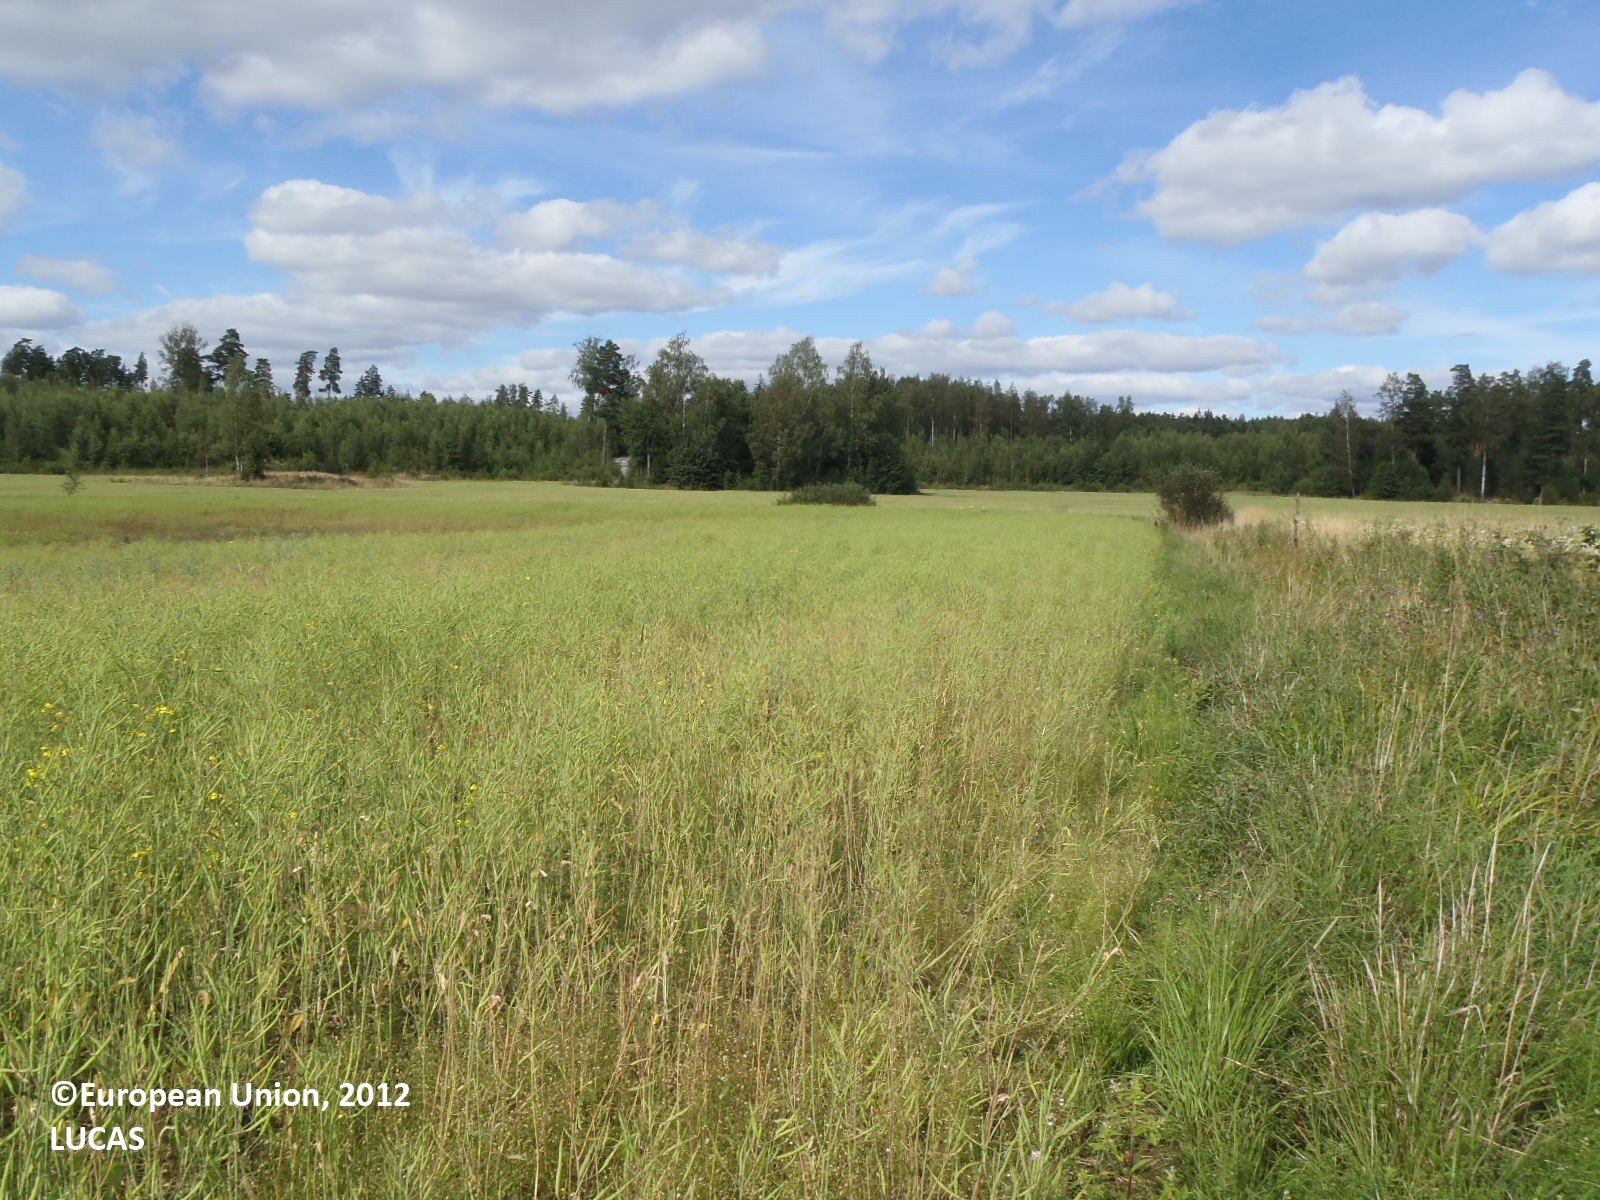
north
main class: Cropland
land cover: Rape and turnip rape
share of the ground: > 75 %
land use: Agriculture (excluding fallow land and kitchen gardens)
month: August
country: FI
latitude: 60.3360
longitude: 22.4791
